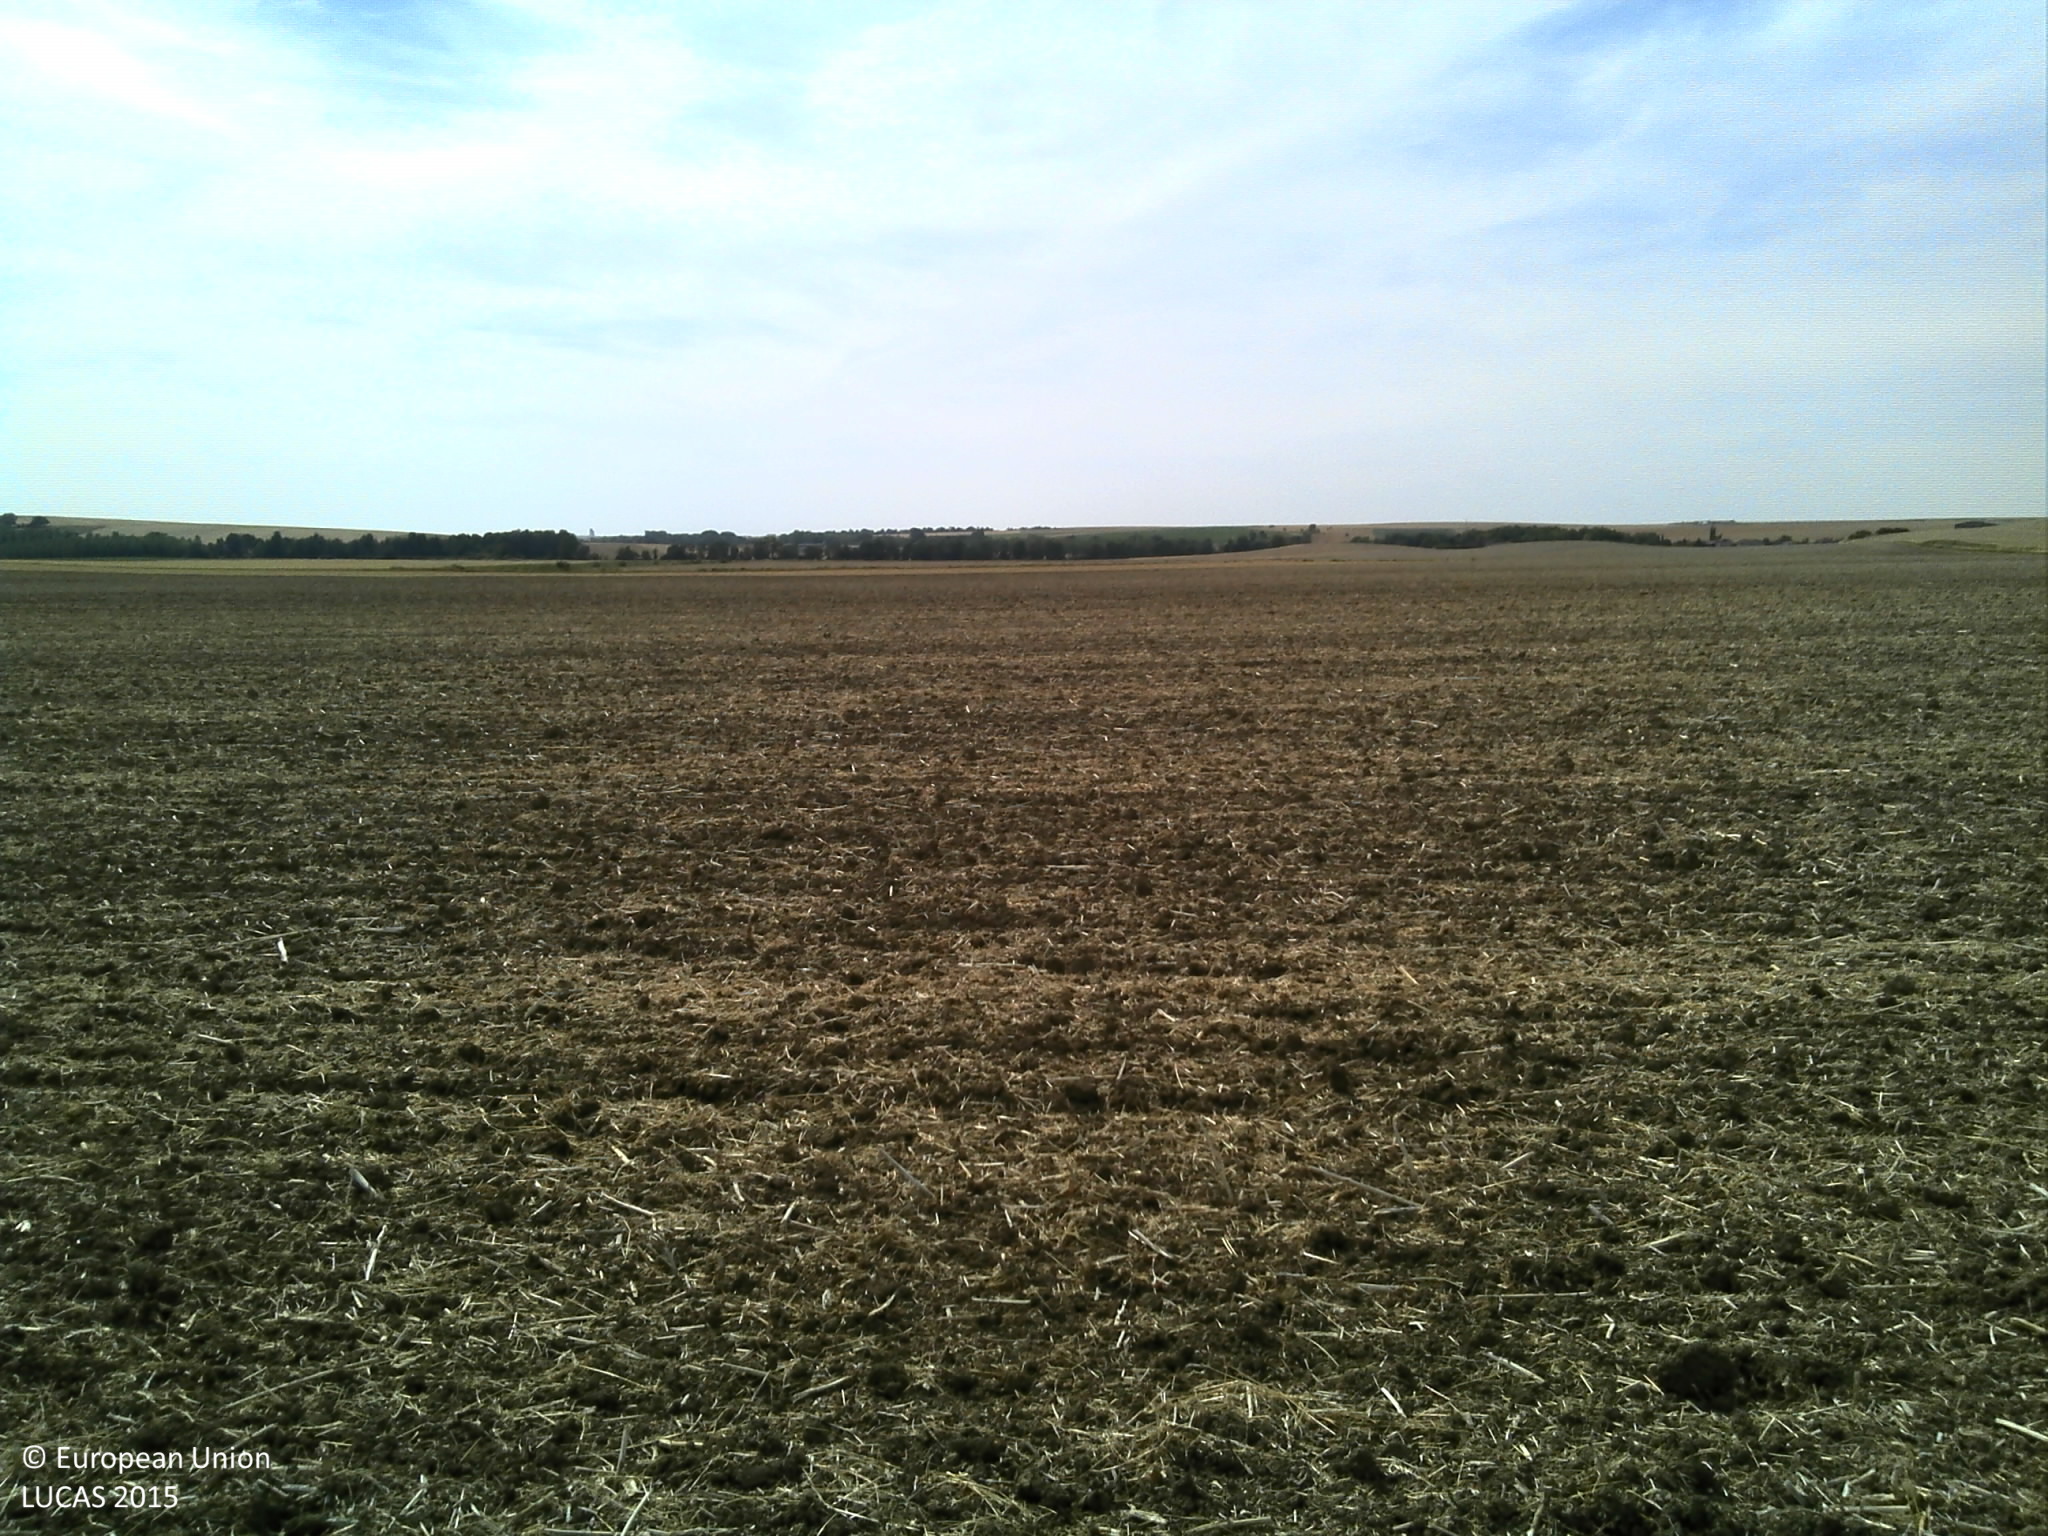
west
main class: Cropland
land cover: Rape and turnip rape
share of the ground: > 75 %
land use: Agriculture (excluding fallow land and kitchen gardens)
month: August
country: FR
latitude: 49.0031
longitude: 4.8167
